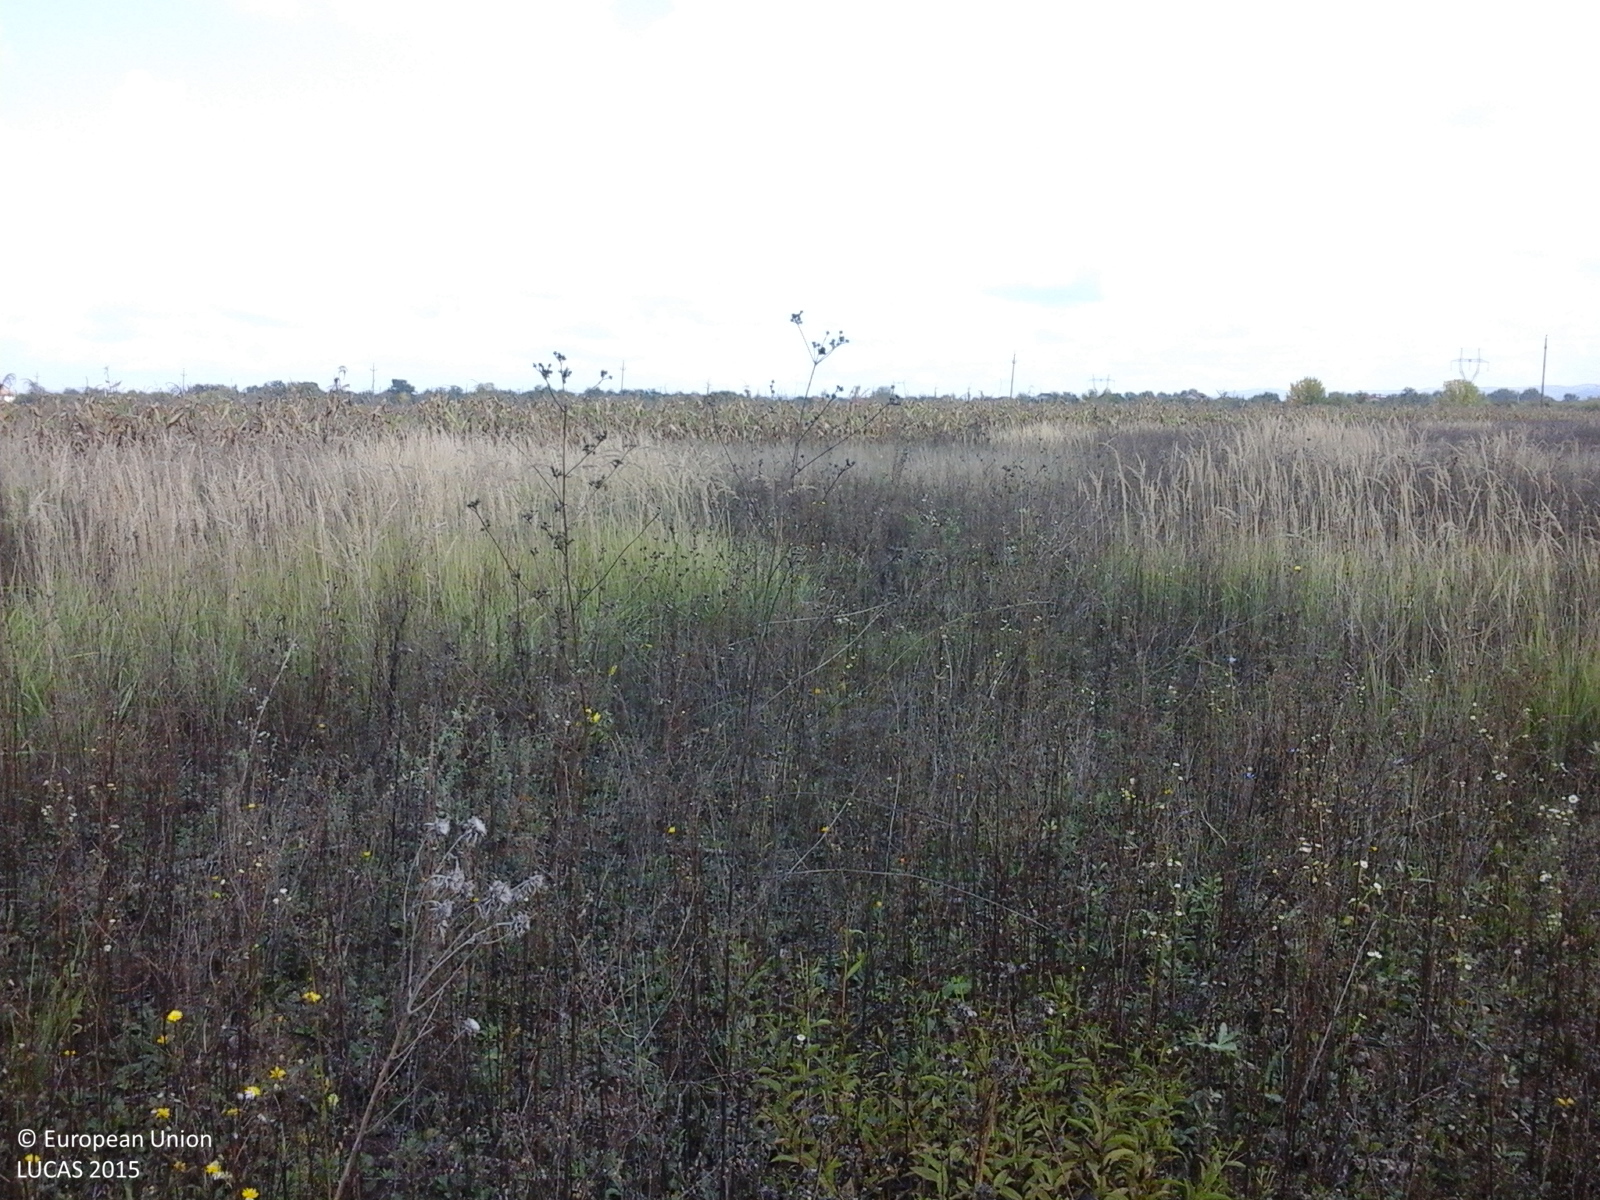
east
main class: Grassland
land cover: Spontaneously vegetated surfaces
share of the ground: > 75 %
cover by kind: herbaceous plants 100 %
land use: Fallow land
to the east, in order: Spontaneously vegetated surfaces; Electric lines; Spontaneously vegetated surfaces; Grass margins; Tracks
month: September
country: RO
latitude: 45.0134
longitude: 23.5206
